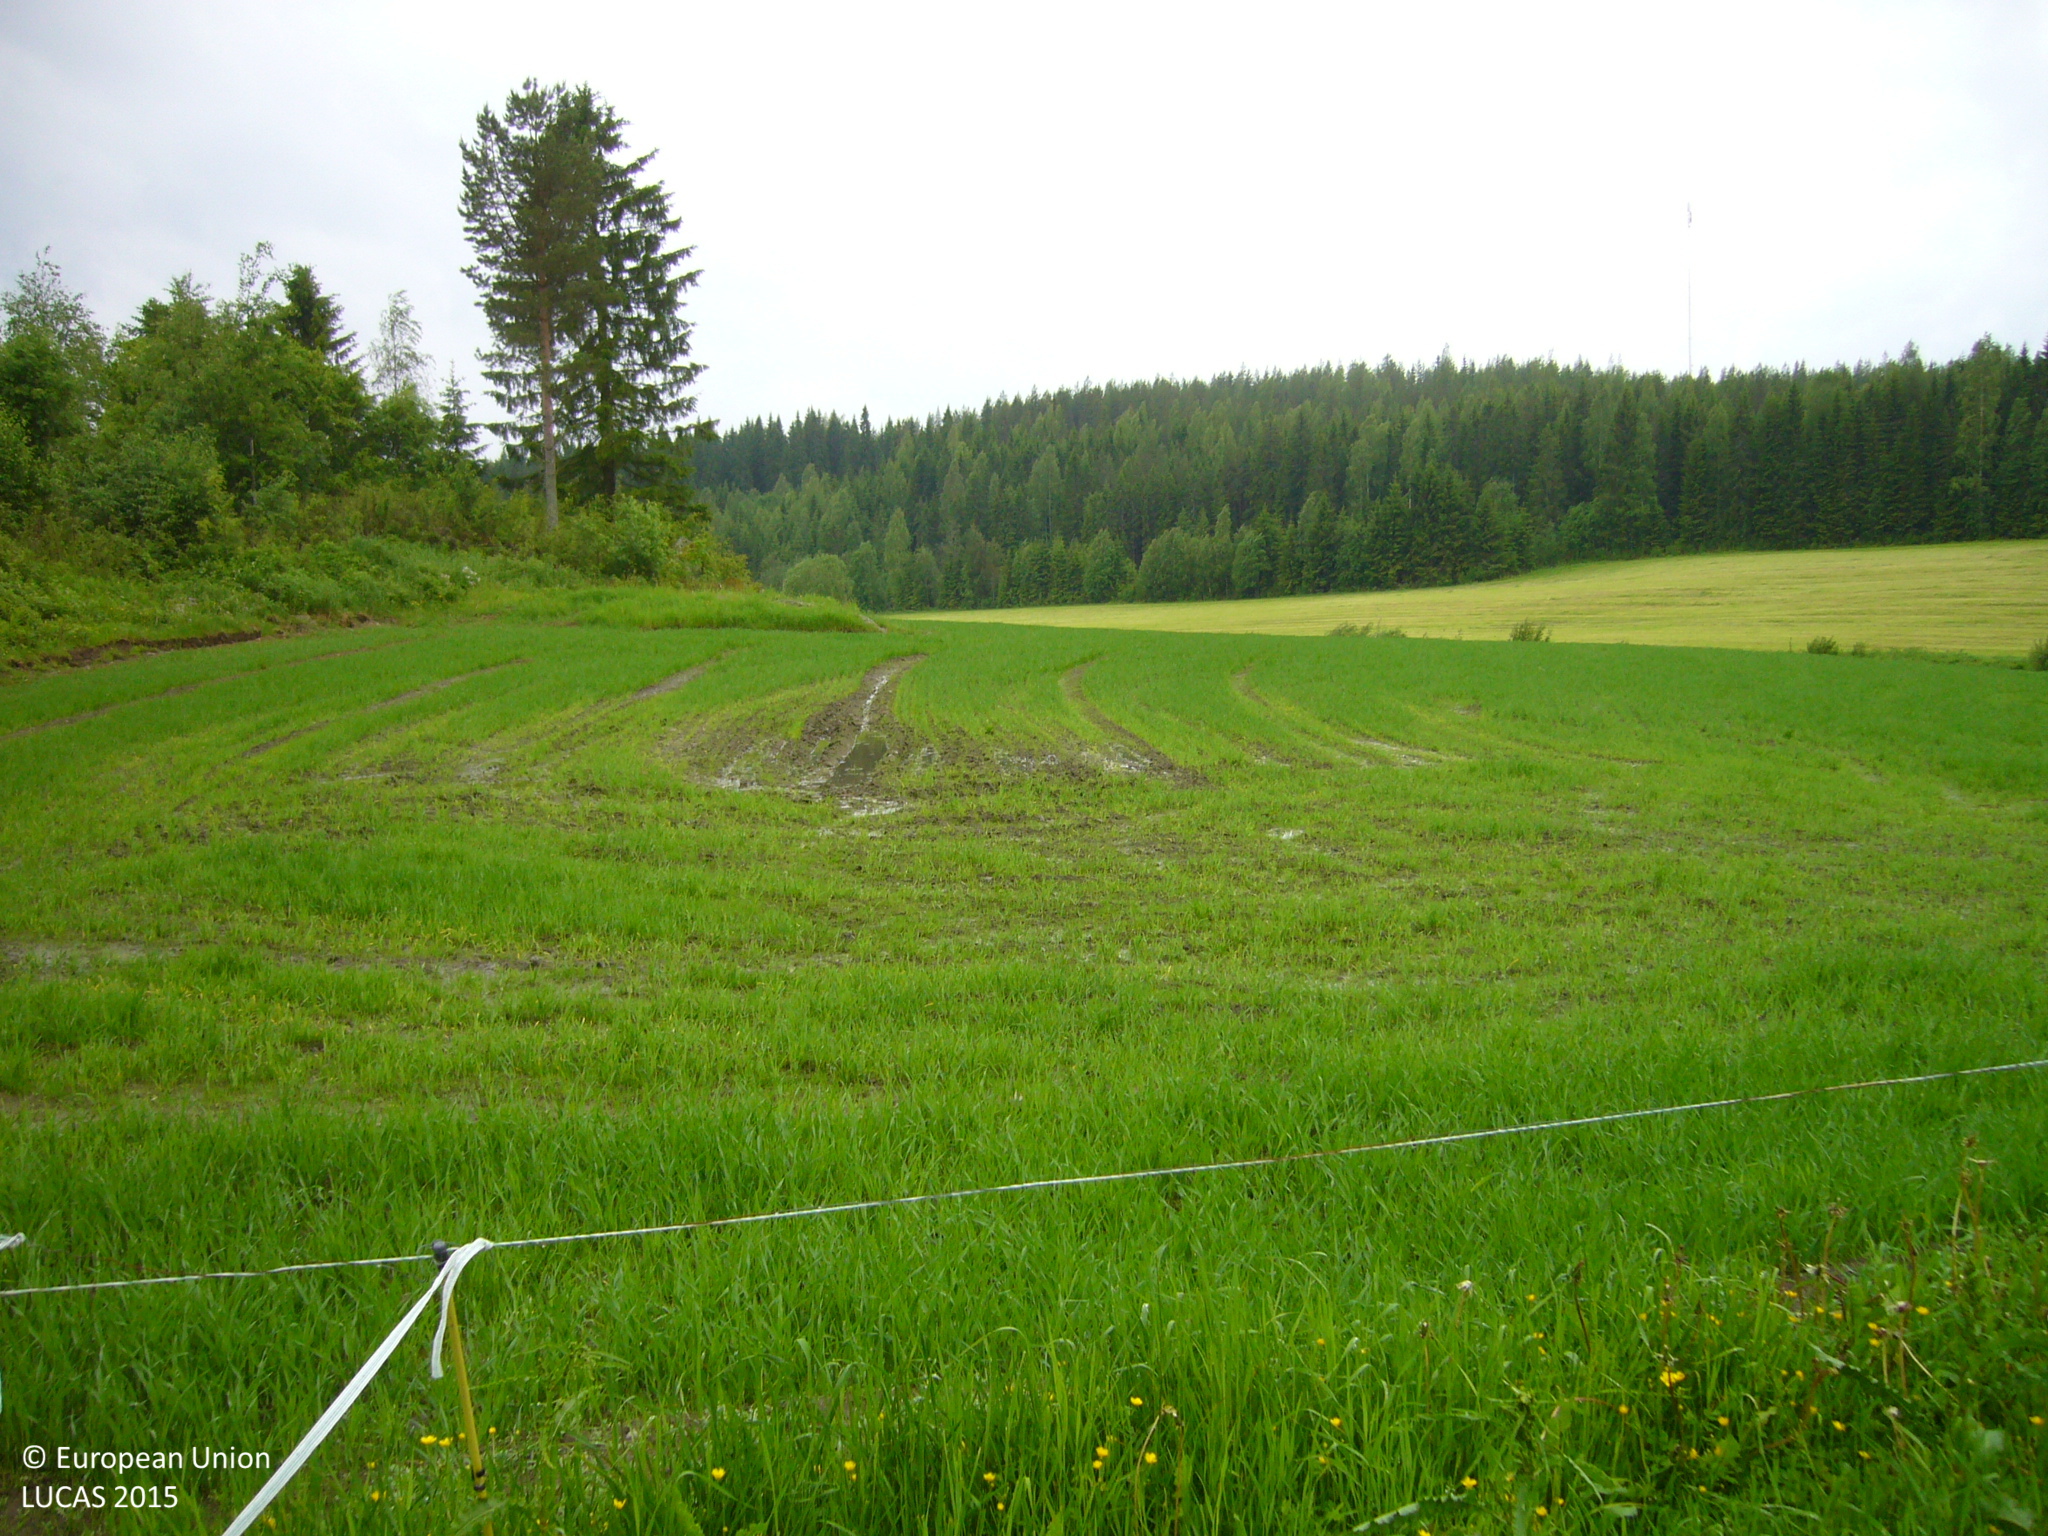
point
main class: Grassland
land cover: Grassland without tree/shrub cover
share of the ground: > 75 %
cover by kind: herbaceous plants 80 %, unconsolidated bare surface 20 %
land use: Agriculture (excluding fallow land and kitchen gardens)
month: June
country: FI
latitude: 63.6236
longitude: 26.4453
